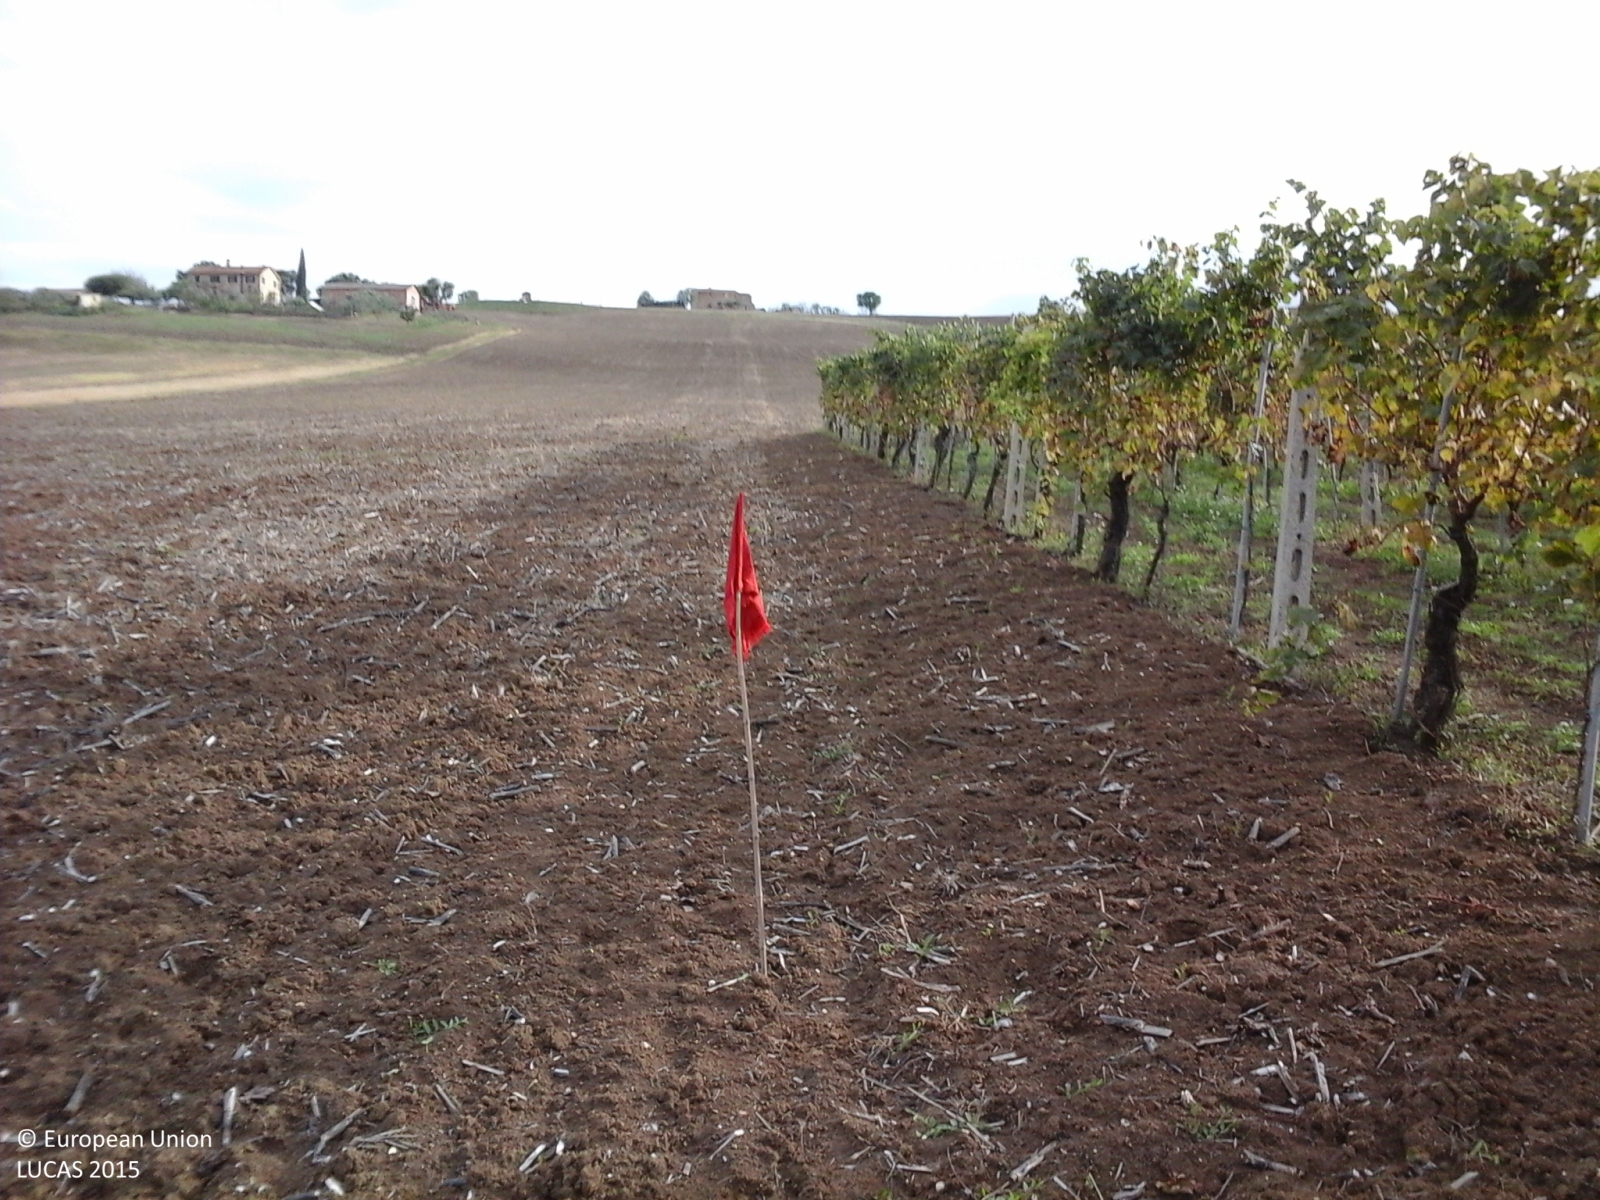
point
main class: Cropland
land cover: Sunflower
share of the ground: < 10 %
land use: Agriculture (excluding fallow land and kitchen gardens)
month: October
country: IT
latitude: 43.5309
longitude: 12.9993
